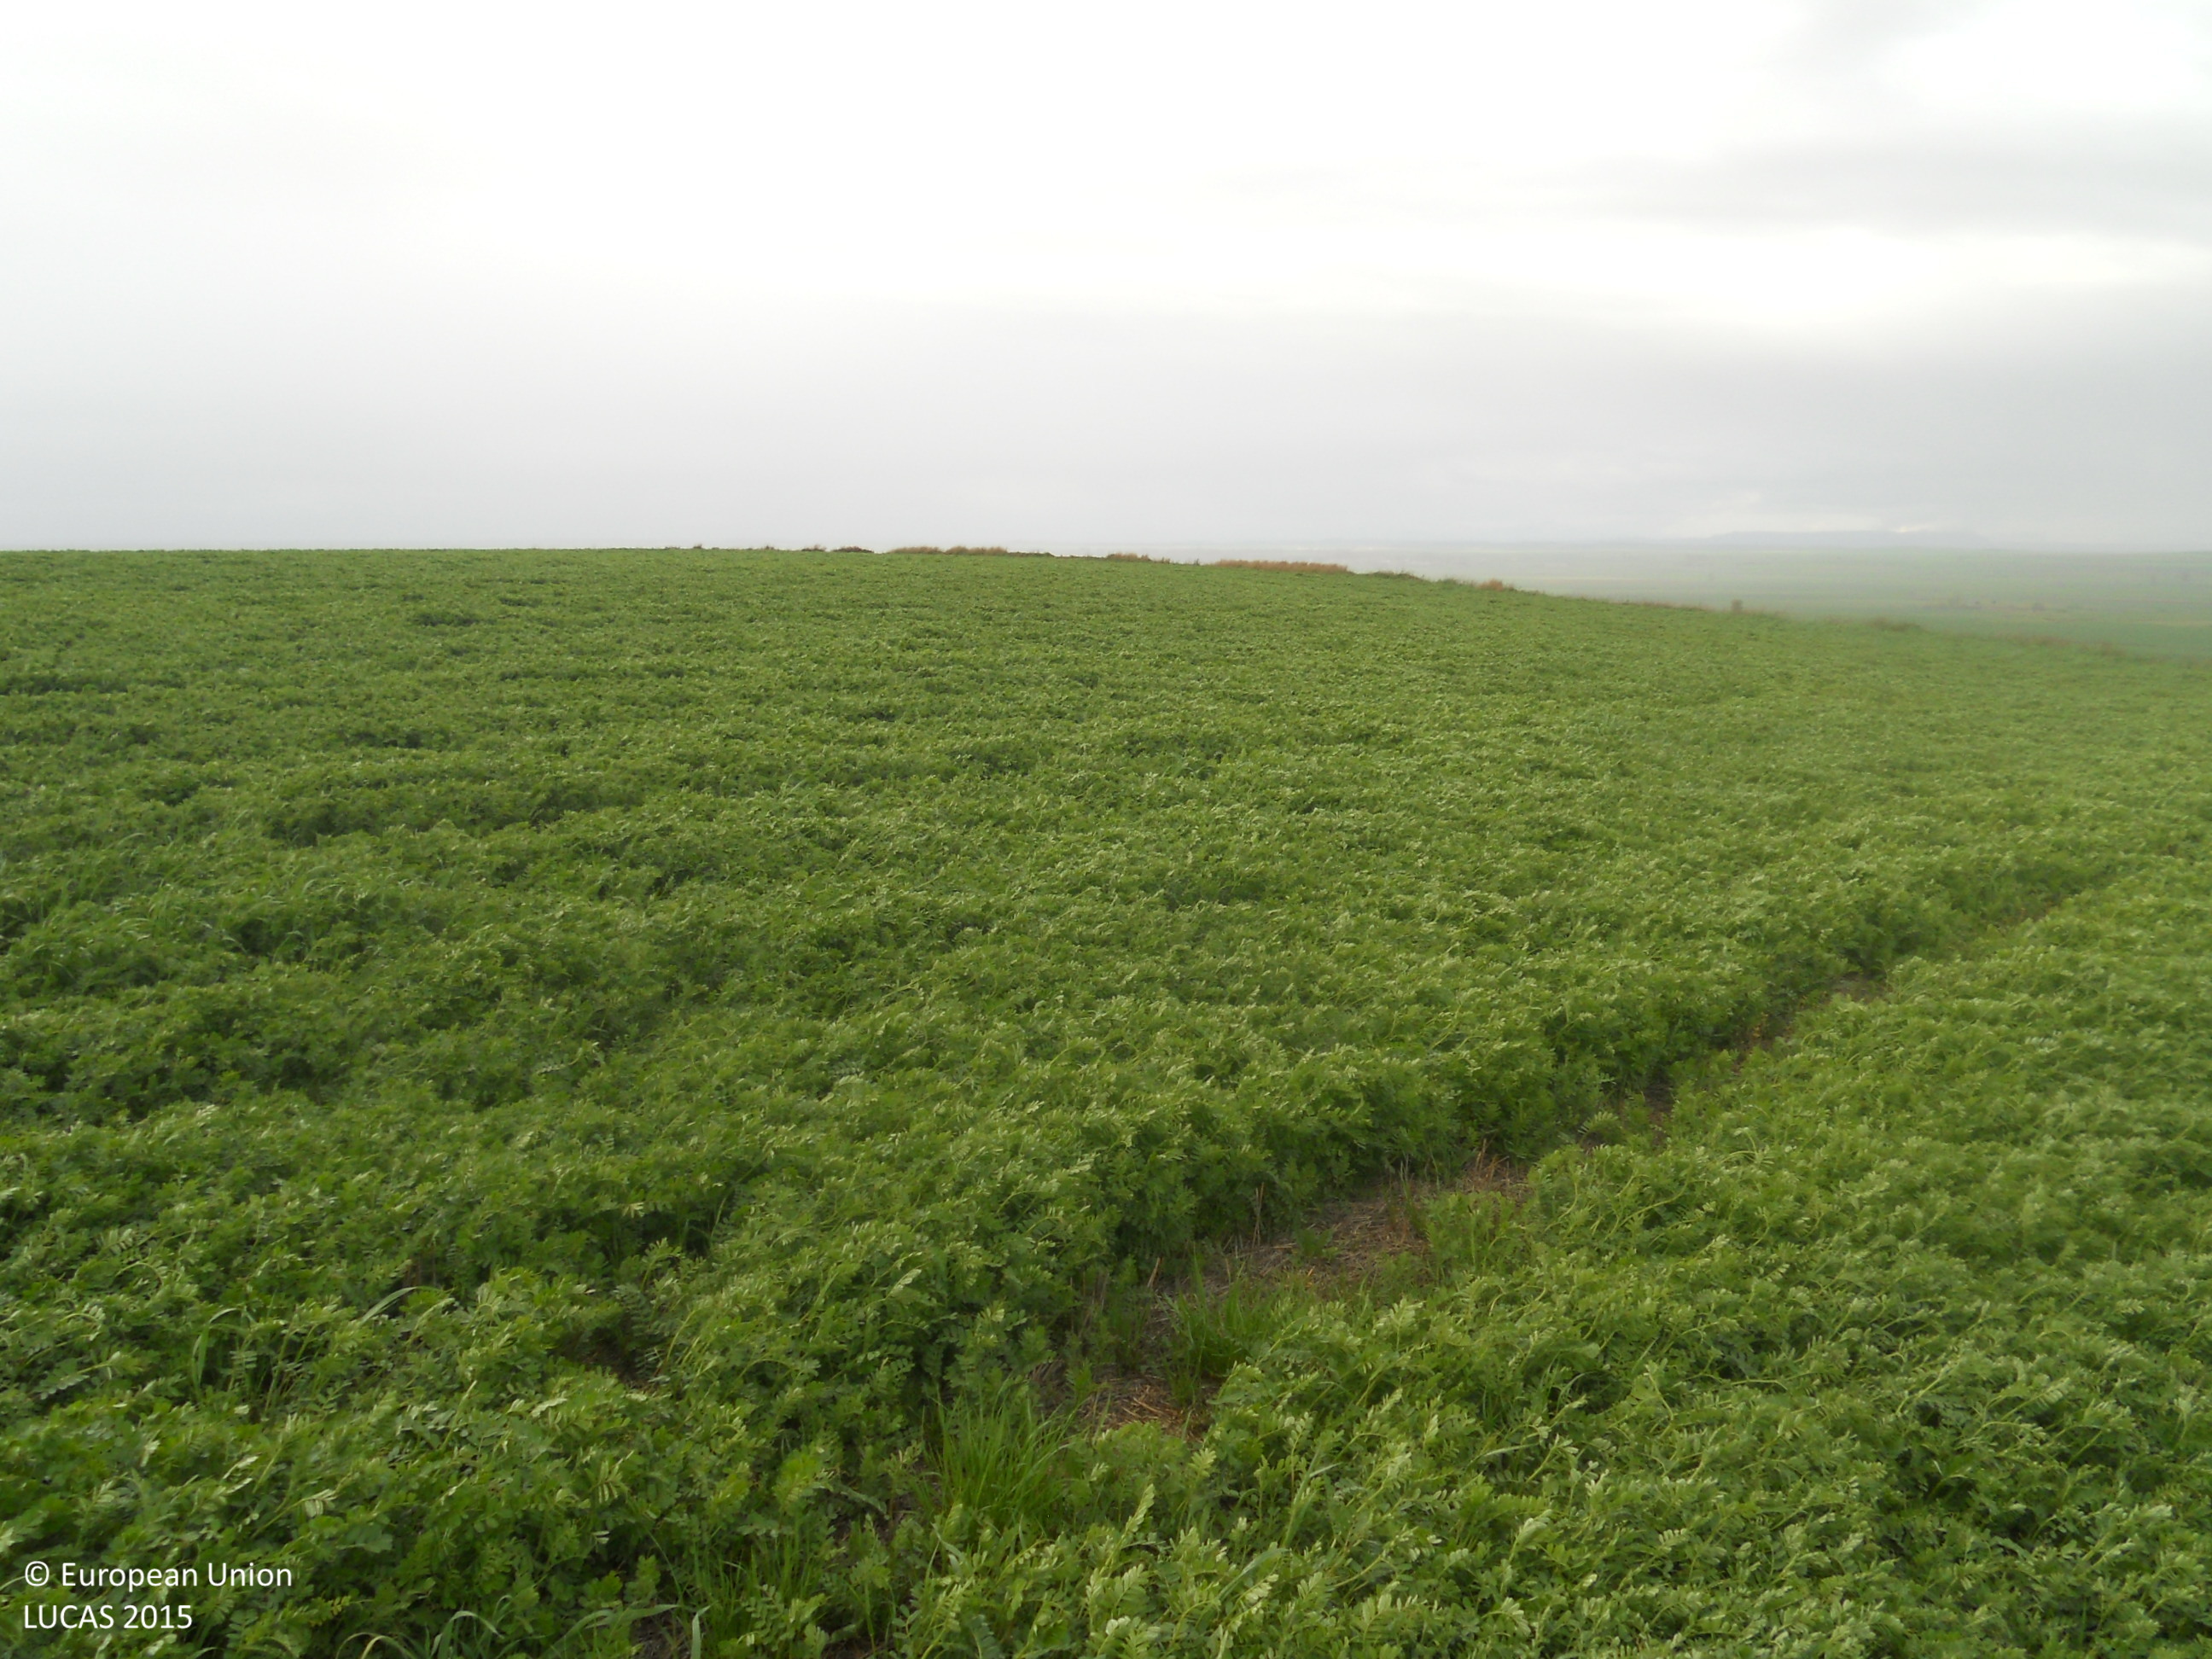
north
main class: Cropland
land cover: Dry pulses
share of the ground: > 75 %
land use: Agriculture (excluding fallow land and kitchen gardens)
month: April
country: ES
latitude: 42.2121
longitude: -4.3508
